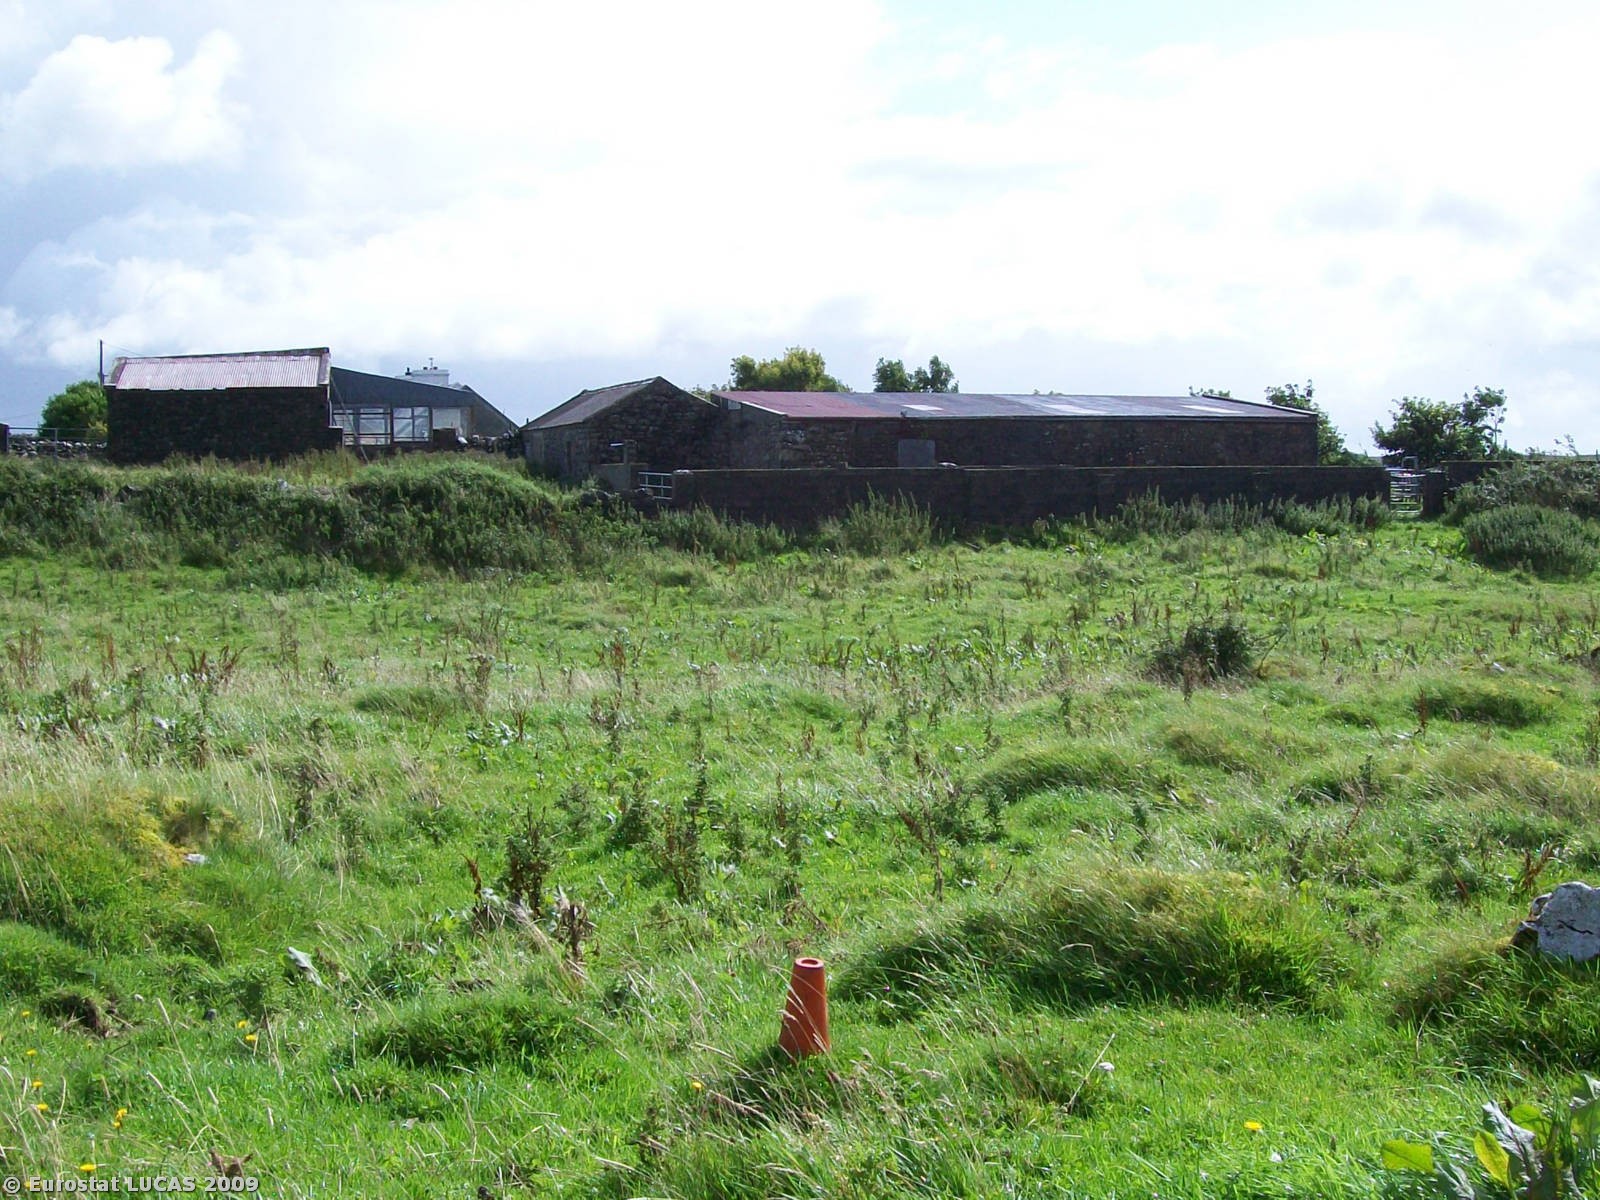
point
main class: Grassland
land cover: Grassland without tree/shrub cover
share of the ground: > 75 %
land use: Agriculture (excluding fallow land and kitchen gardens)
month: August
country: IE
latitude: 53.0361
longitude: -9.2674
